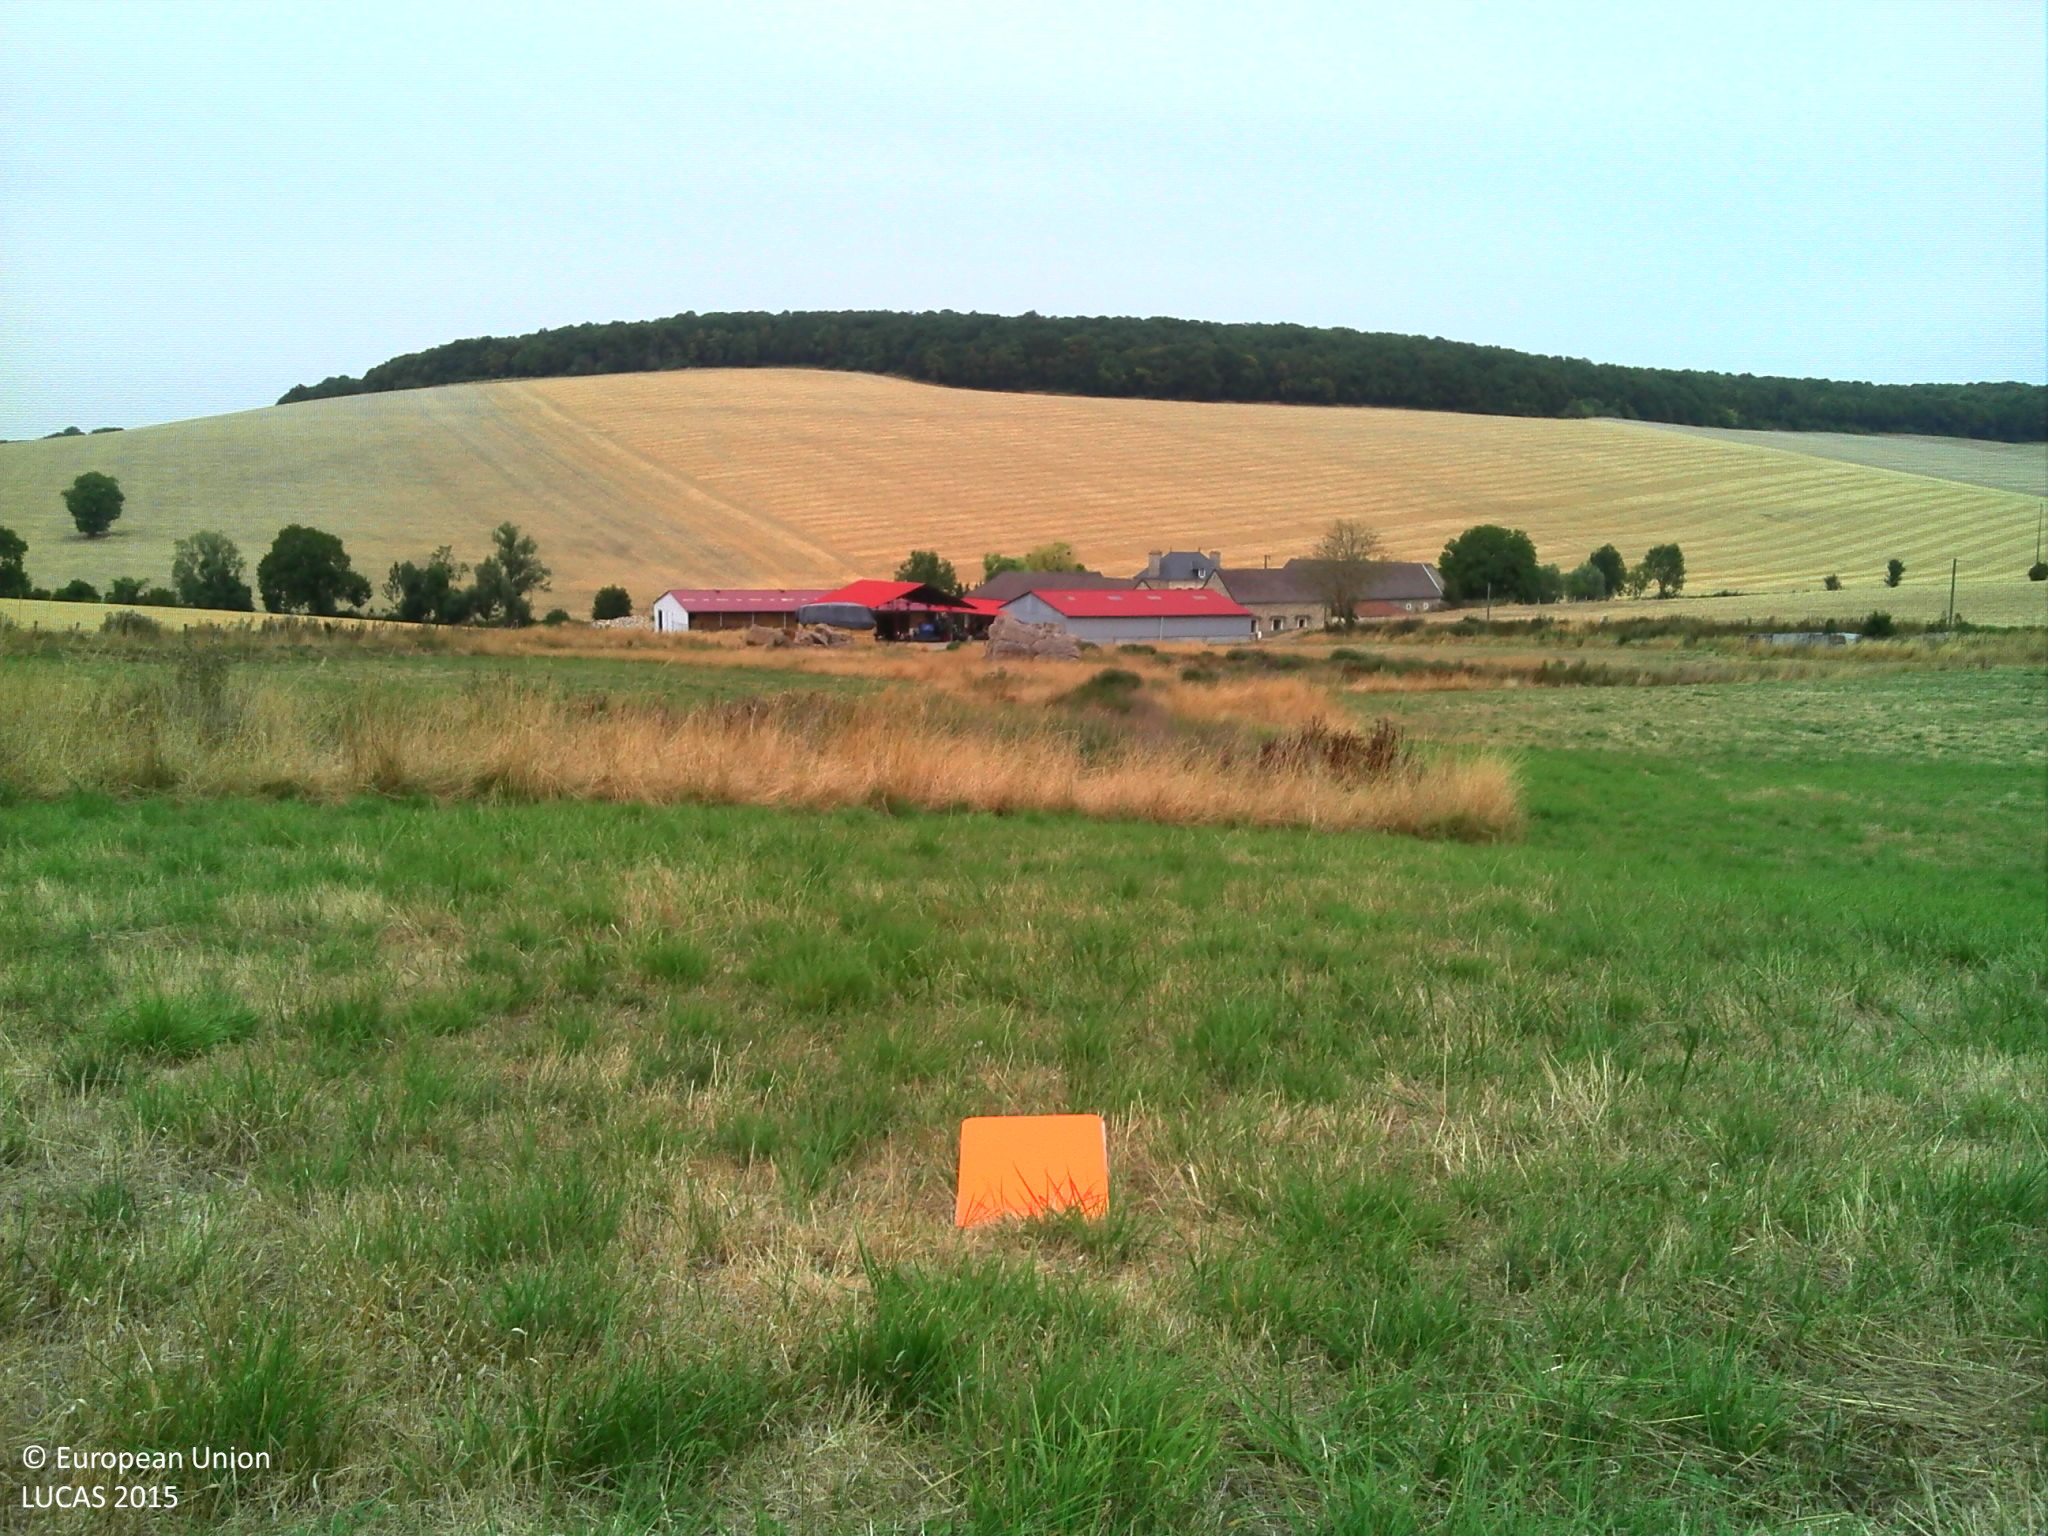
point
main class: Grassland
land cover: Grassland without tree/shrub cover
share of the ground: > 75 %
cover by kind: herbaceous plants 90 %, unconsolidated bare surface 5 %
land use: Agriculture (excluding fallow land and kitchen gardens)
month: August
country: FR
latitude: 49.2143
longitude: 3.6651
